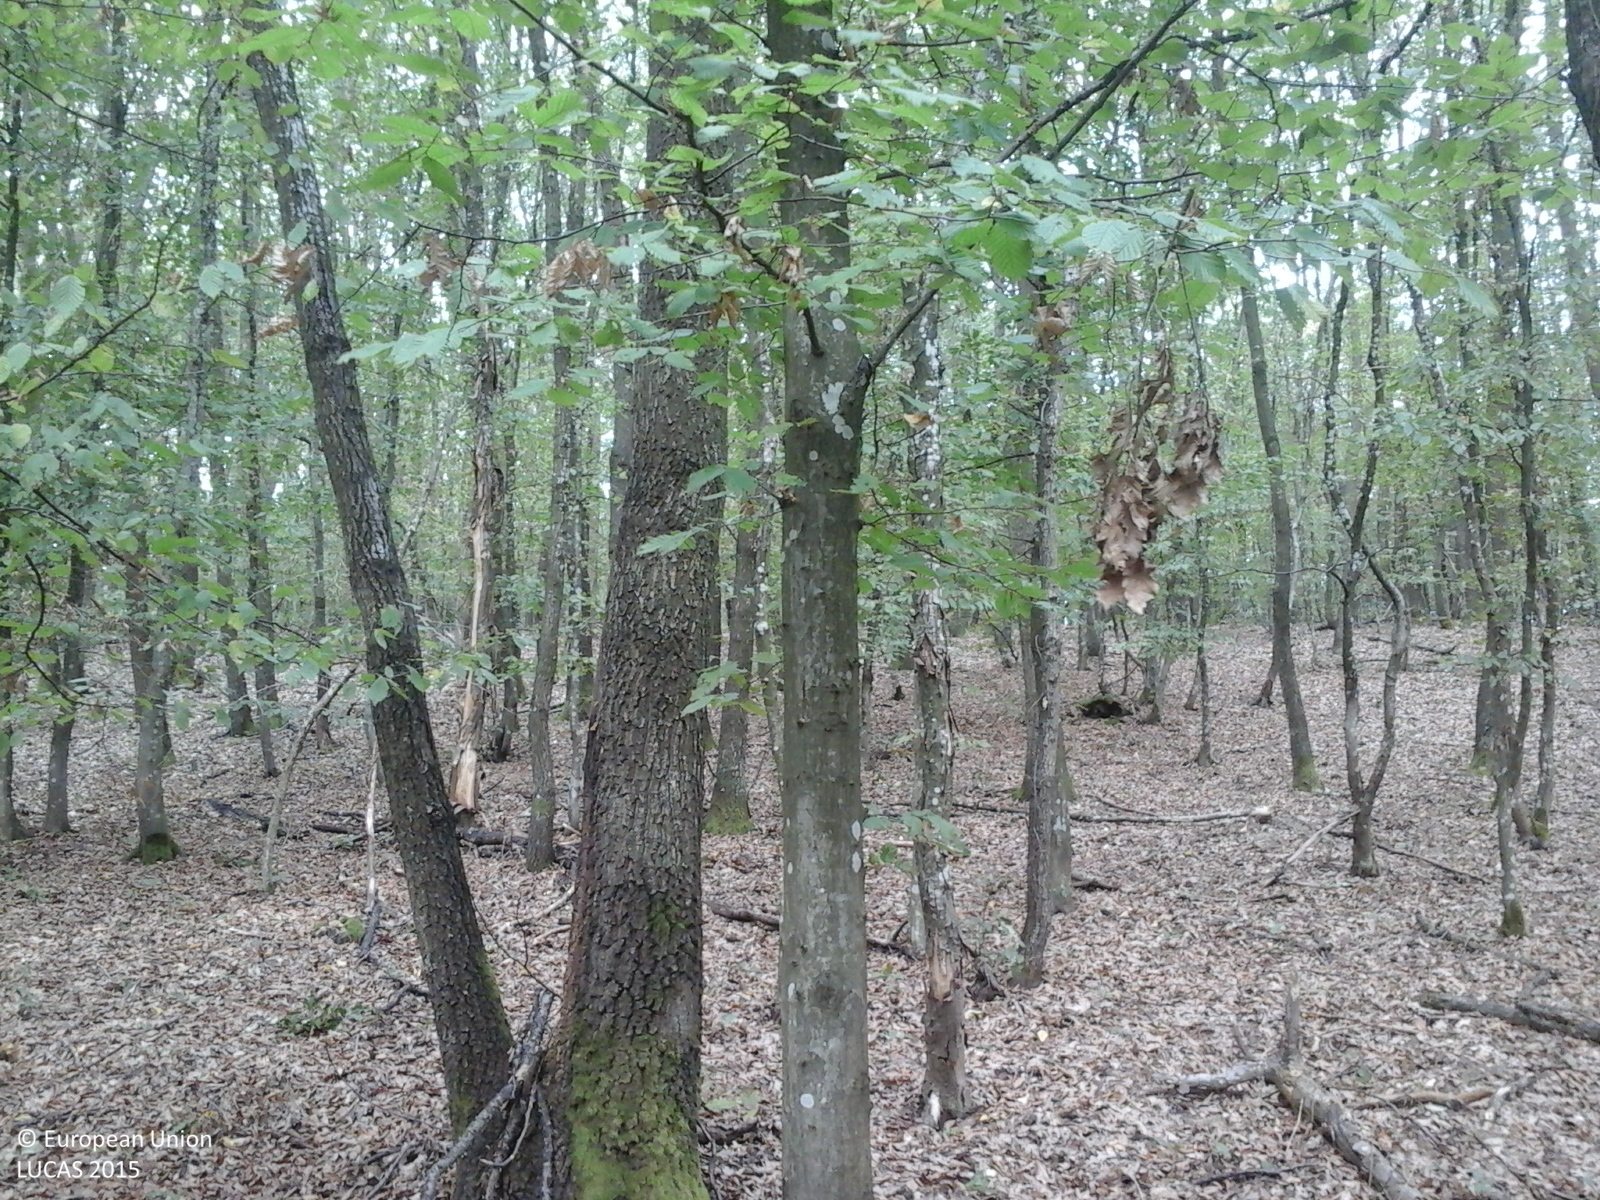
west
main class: Woodland
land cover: Broadleaved woodland
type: acidophilous oak and oak-birch forest
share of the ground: > 75 %
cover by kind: broadleaved forest trees 100 %
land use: Forestry
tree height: > 5 m
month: September
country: RO
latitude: 47.0296
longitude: 23.4522
